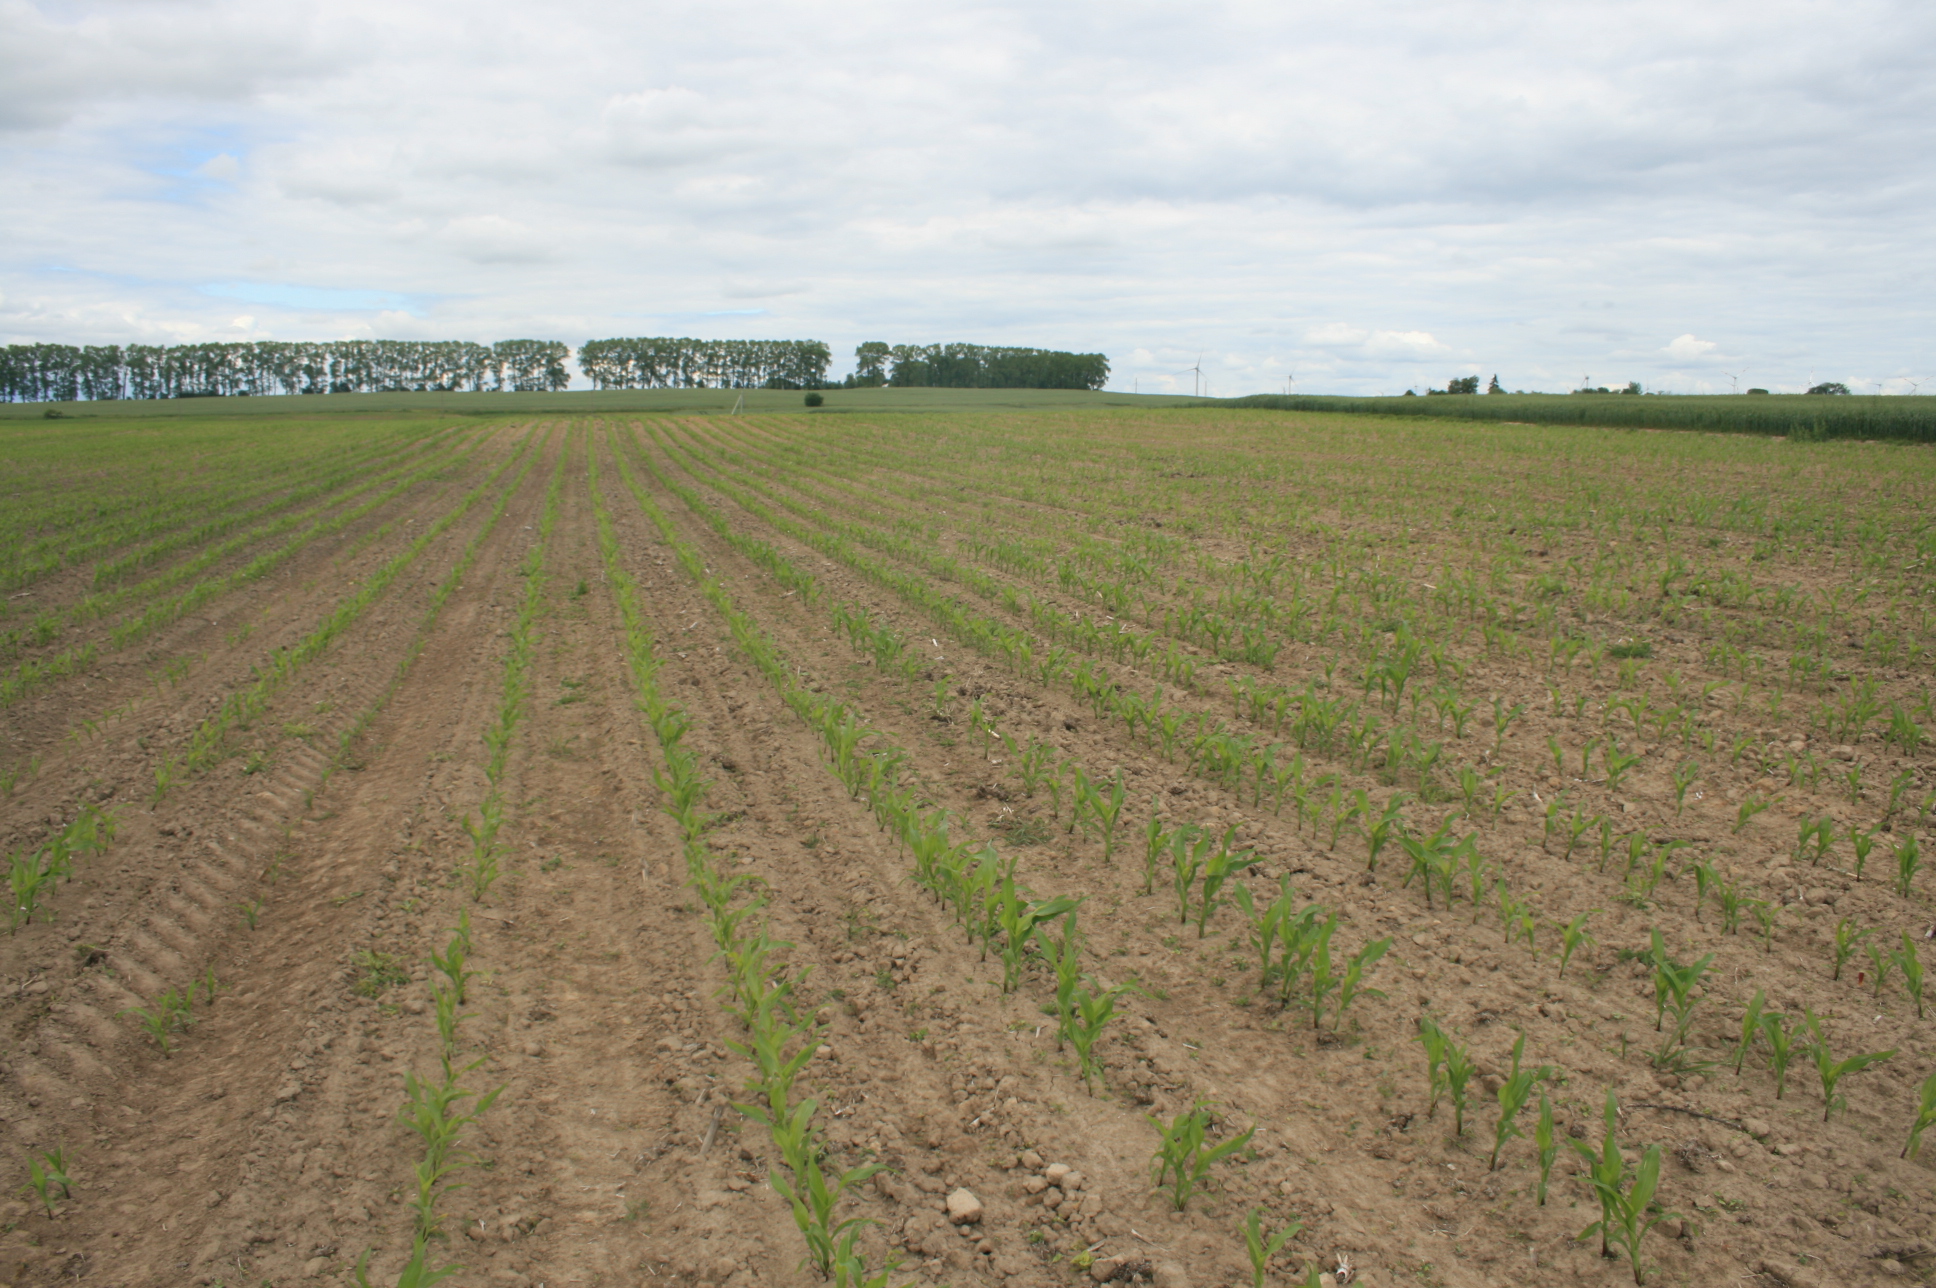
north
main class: Cropland
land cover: Maize
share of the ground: 25 - 50 %
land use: Agriculture (excluding fallow land and kitchen gardens)
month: June
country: LT
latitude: 55.1465
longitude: 22.0262
